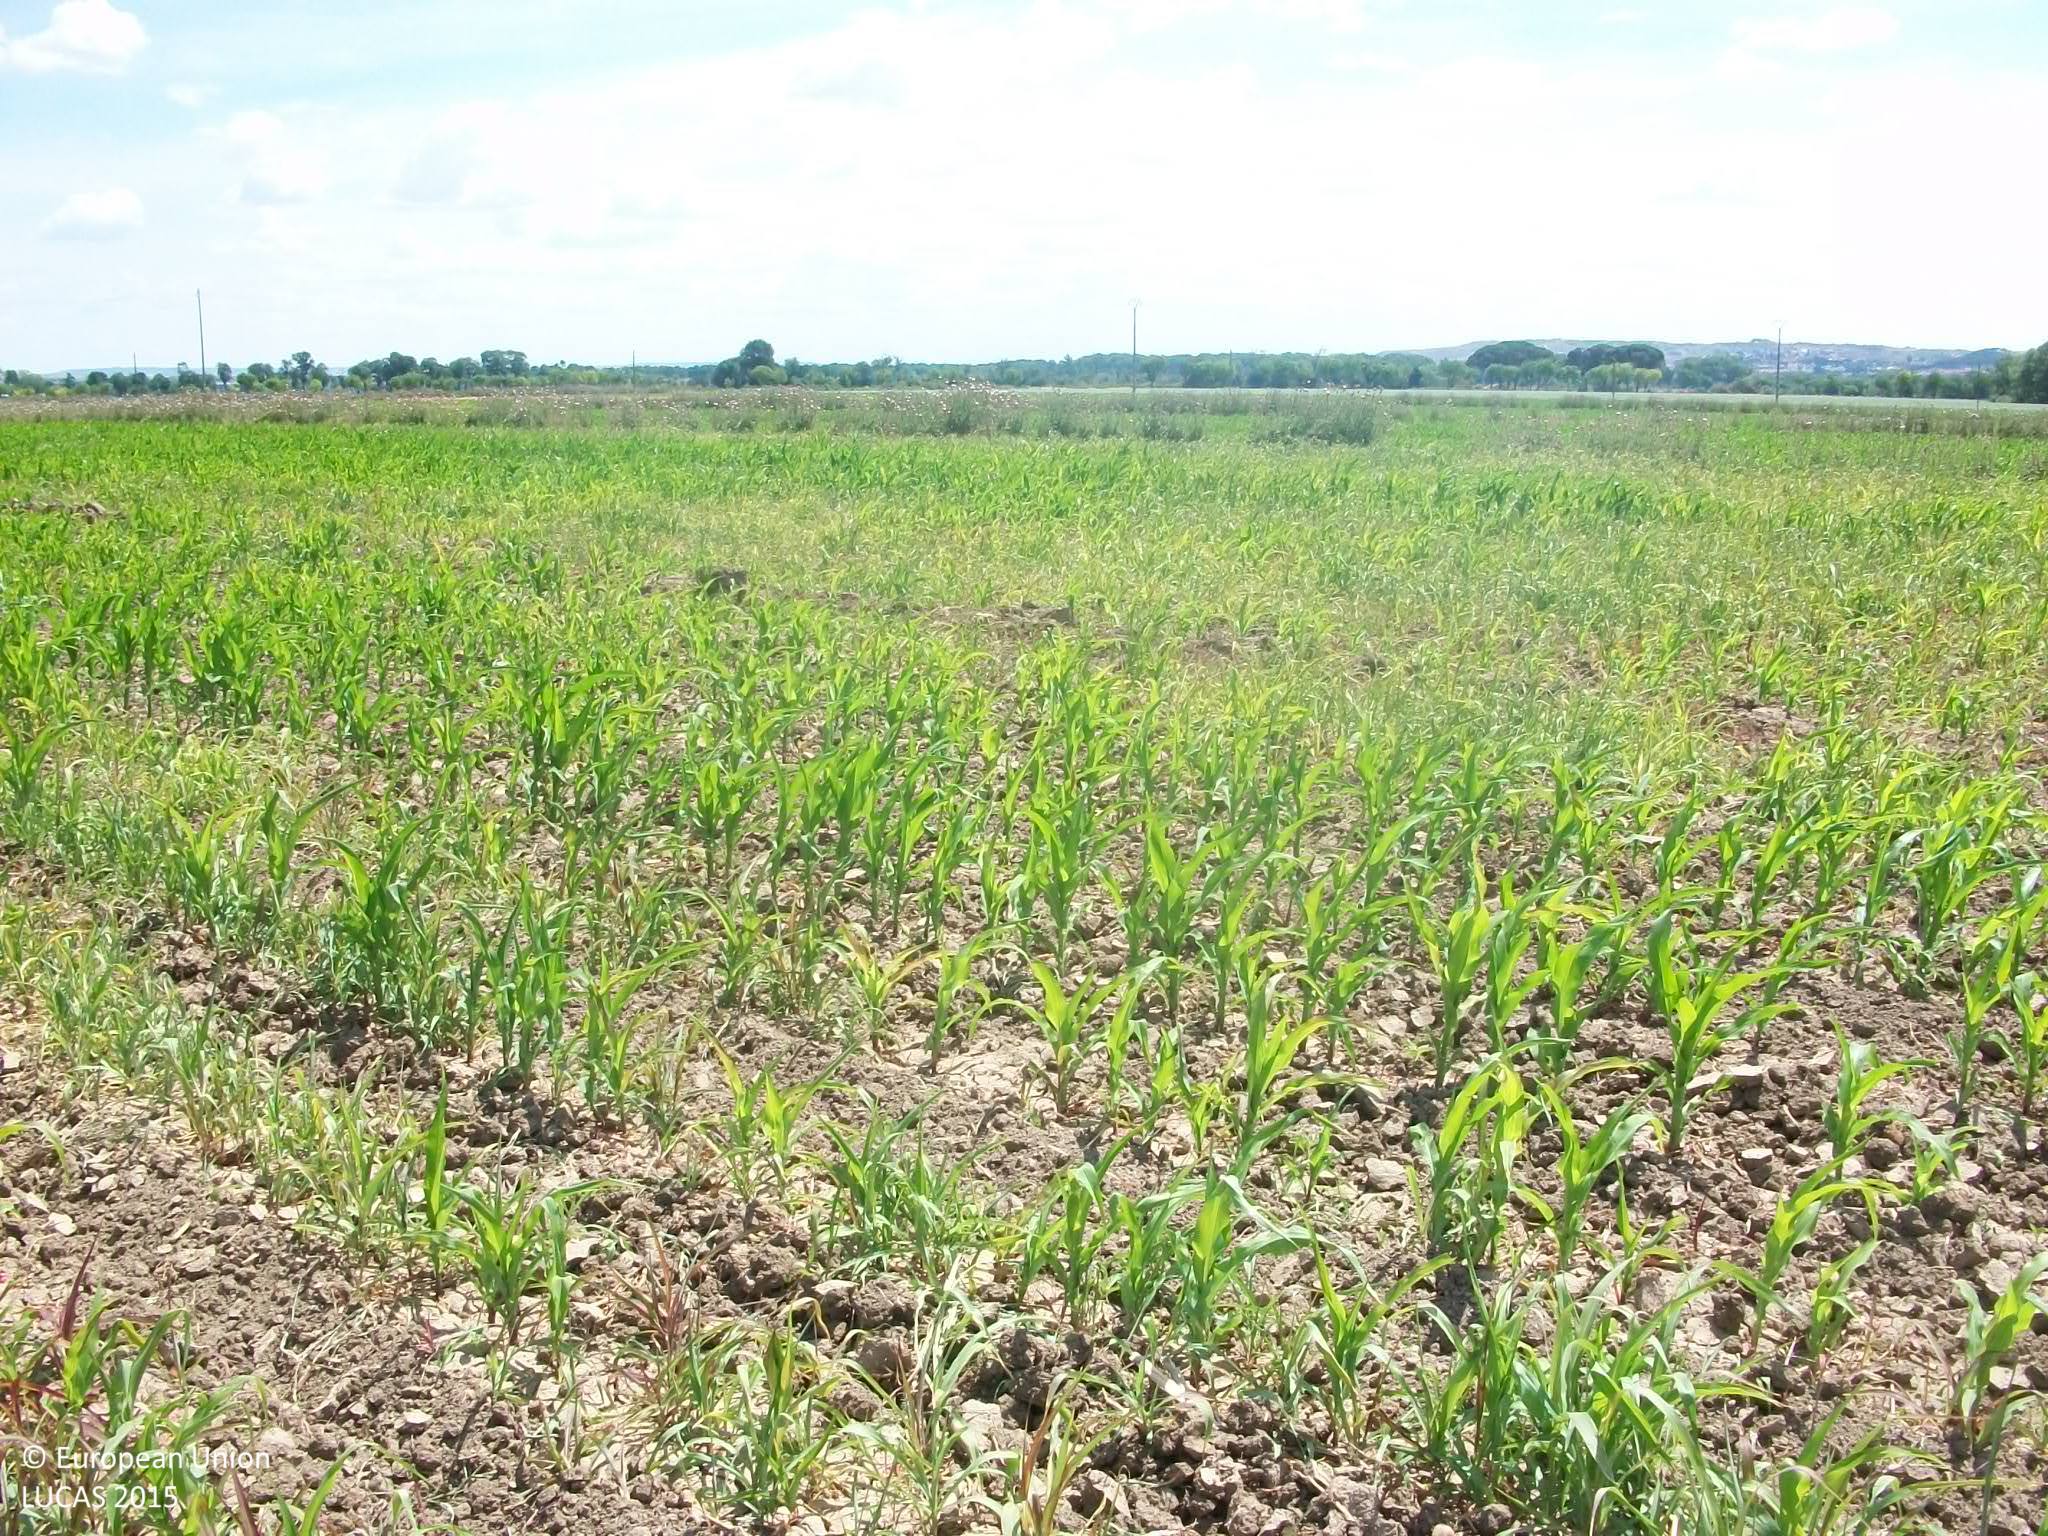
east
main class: Cropland
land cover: Maize
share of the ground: 50 - 75 %
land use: Agriculture (excluding fallow land and kitchen gardens)
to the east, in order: Maize; Grass margins; Maize; Grass margins; Maize; Grass margins; Maize; Electric lines
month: May
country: ES
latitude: 40.0394
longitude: -3.6624
